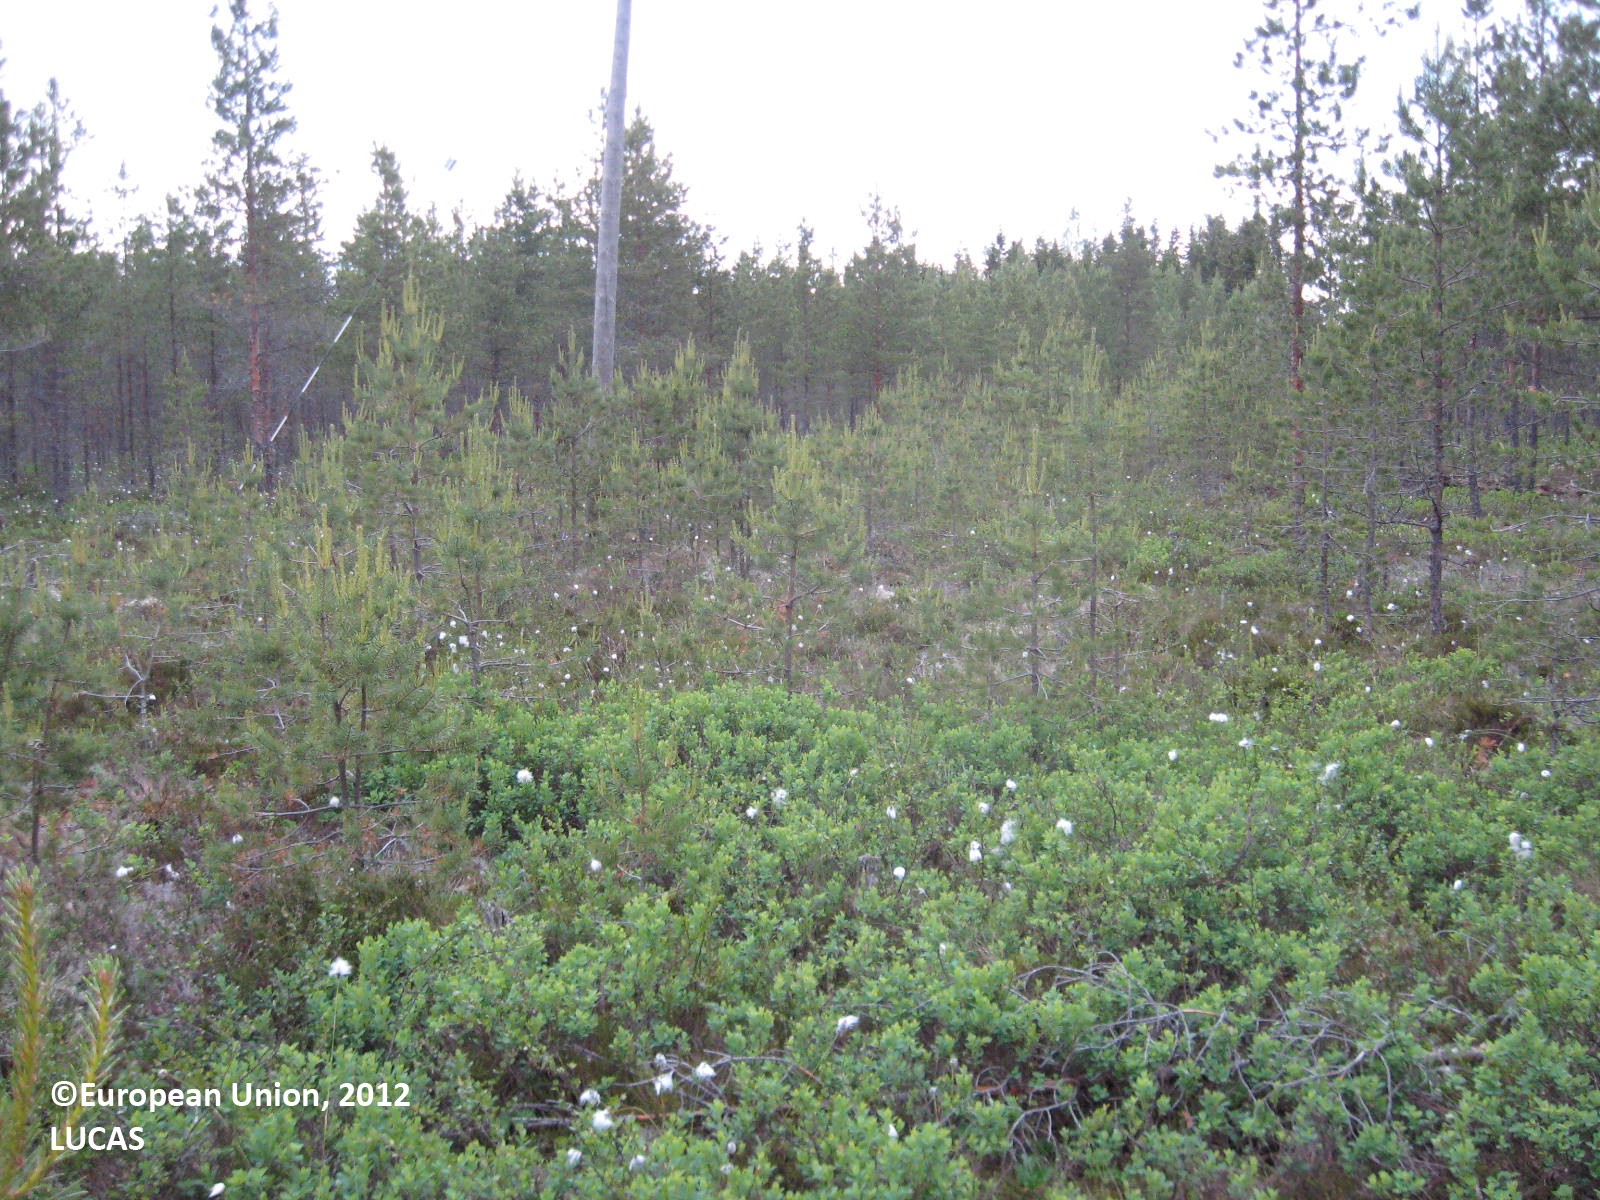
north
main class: Woodland
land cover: Pine dominated coniferous woodland
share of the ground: > 75 %
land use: Forestry
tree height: < 5 m
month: June
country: FI
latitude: 62.8987
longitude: 22.6668
